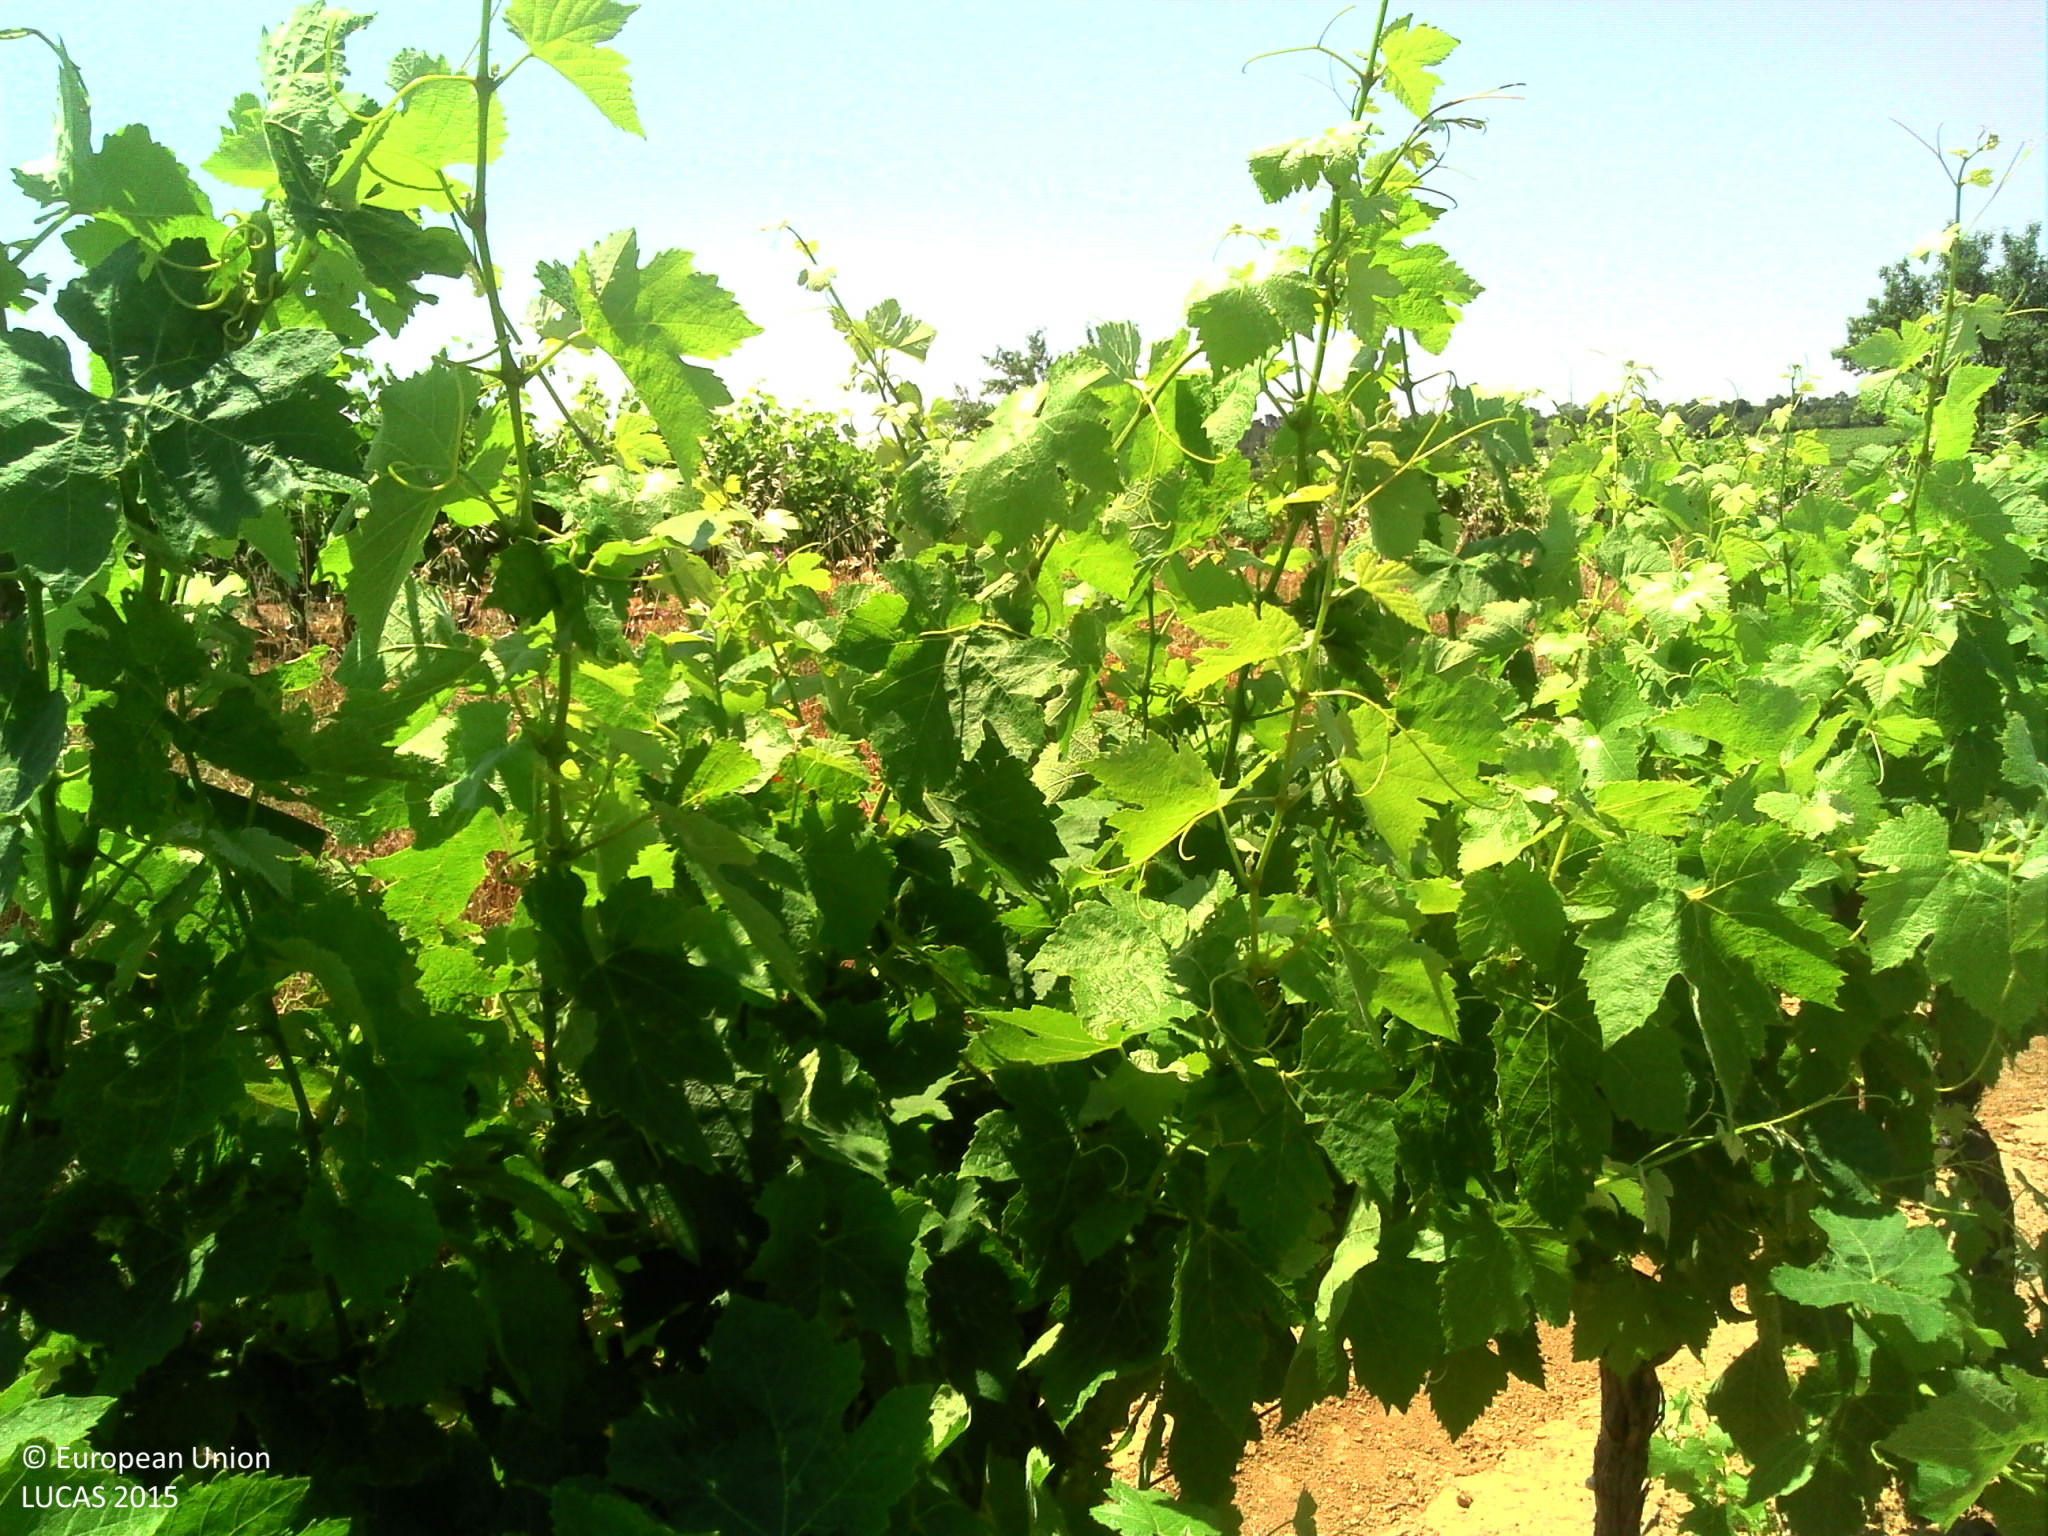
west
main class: Cropland
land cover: Vineyards
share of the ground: > 75 %
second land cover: Other bare soil
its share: > 75 %
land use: Agriculture (excluding fallow land and kitchen gardens)
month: June
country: FR
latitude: 43.2338
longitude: 3.1018
